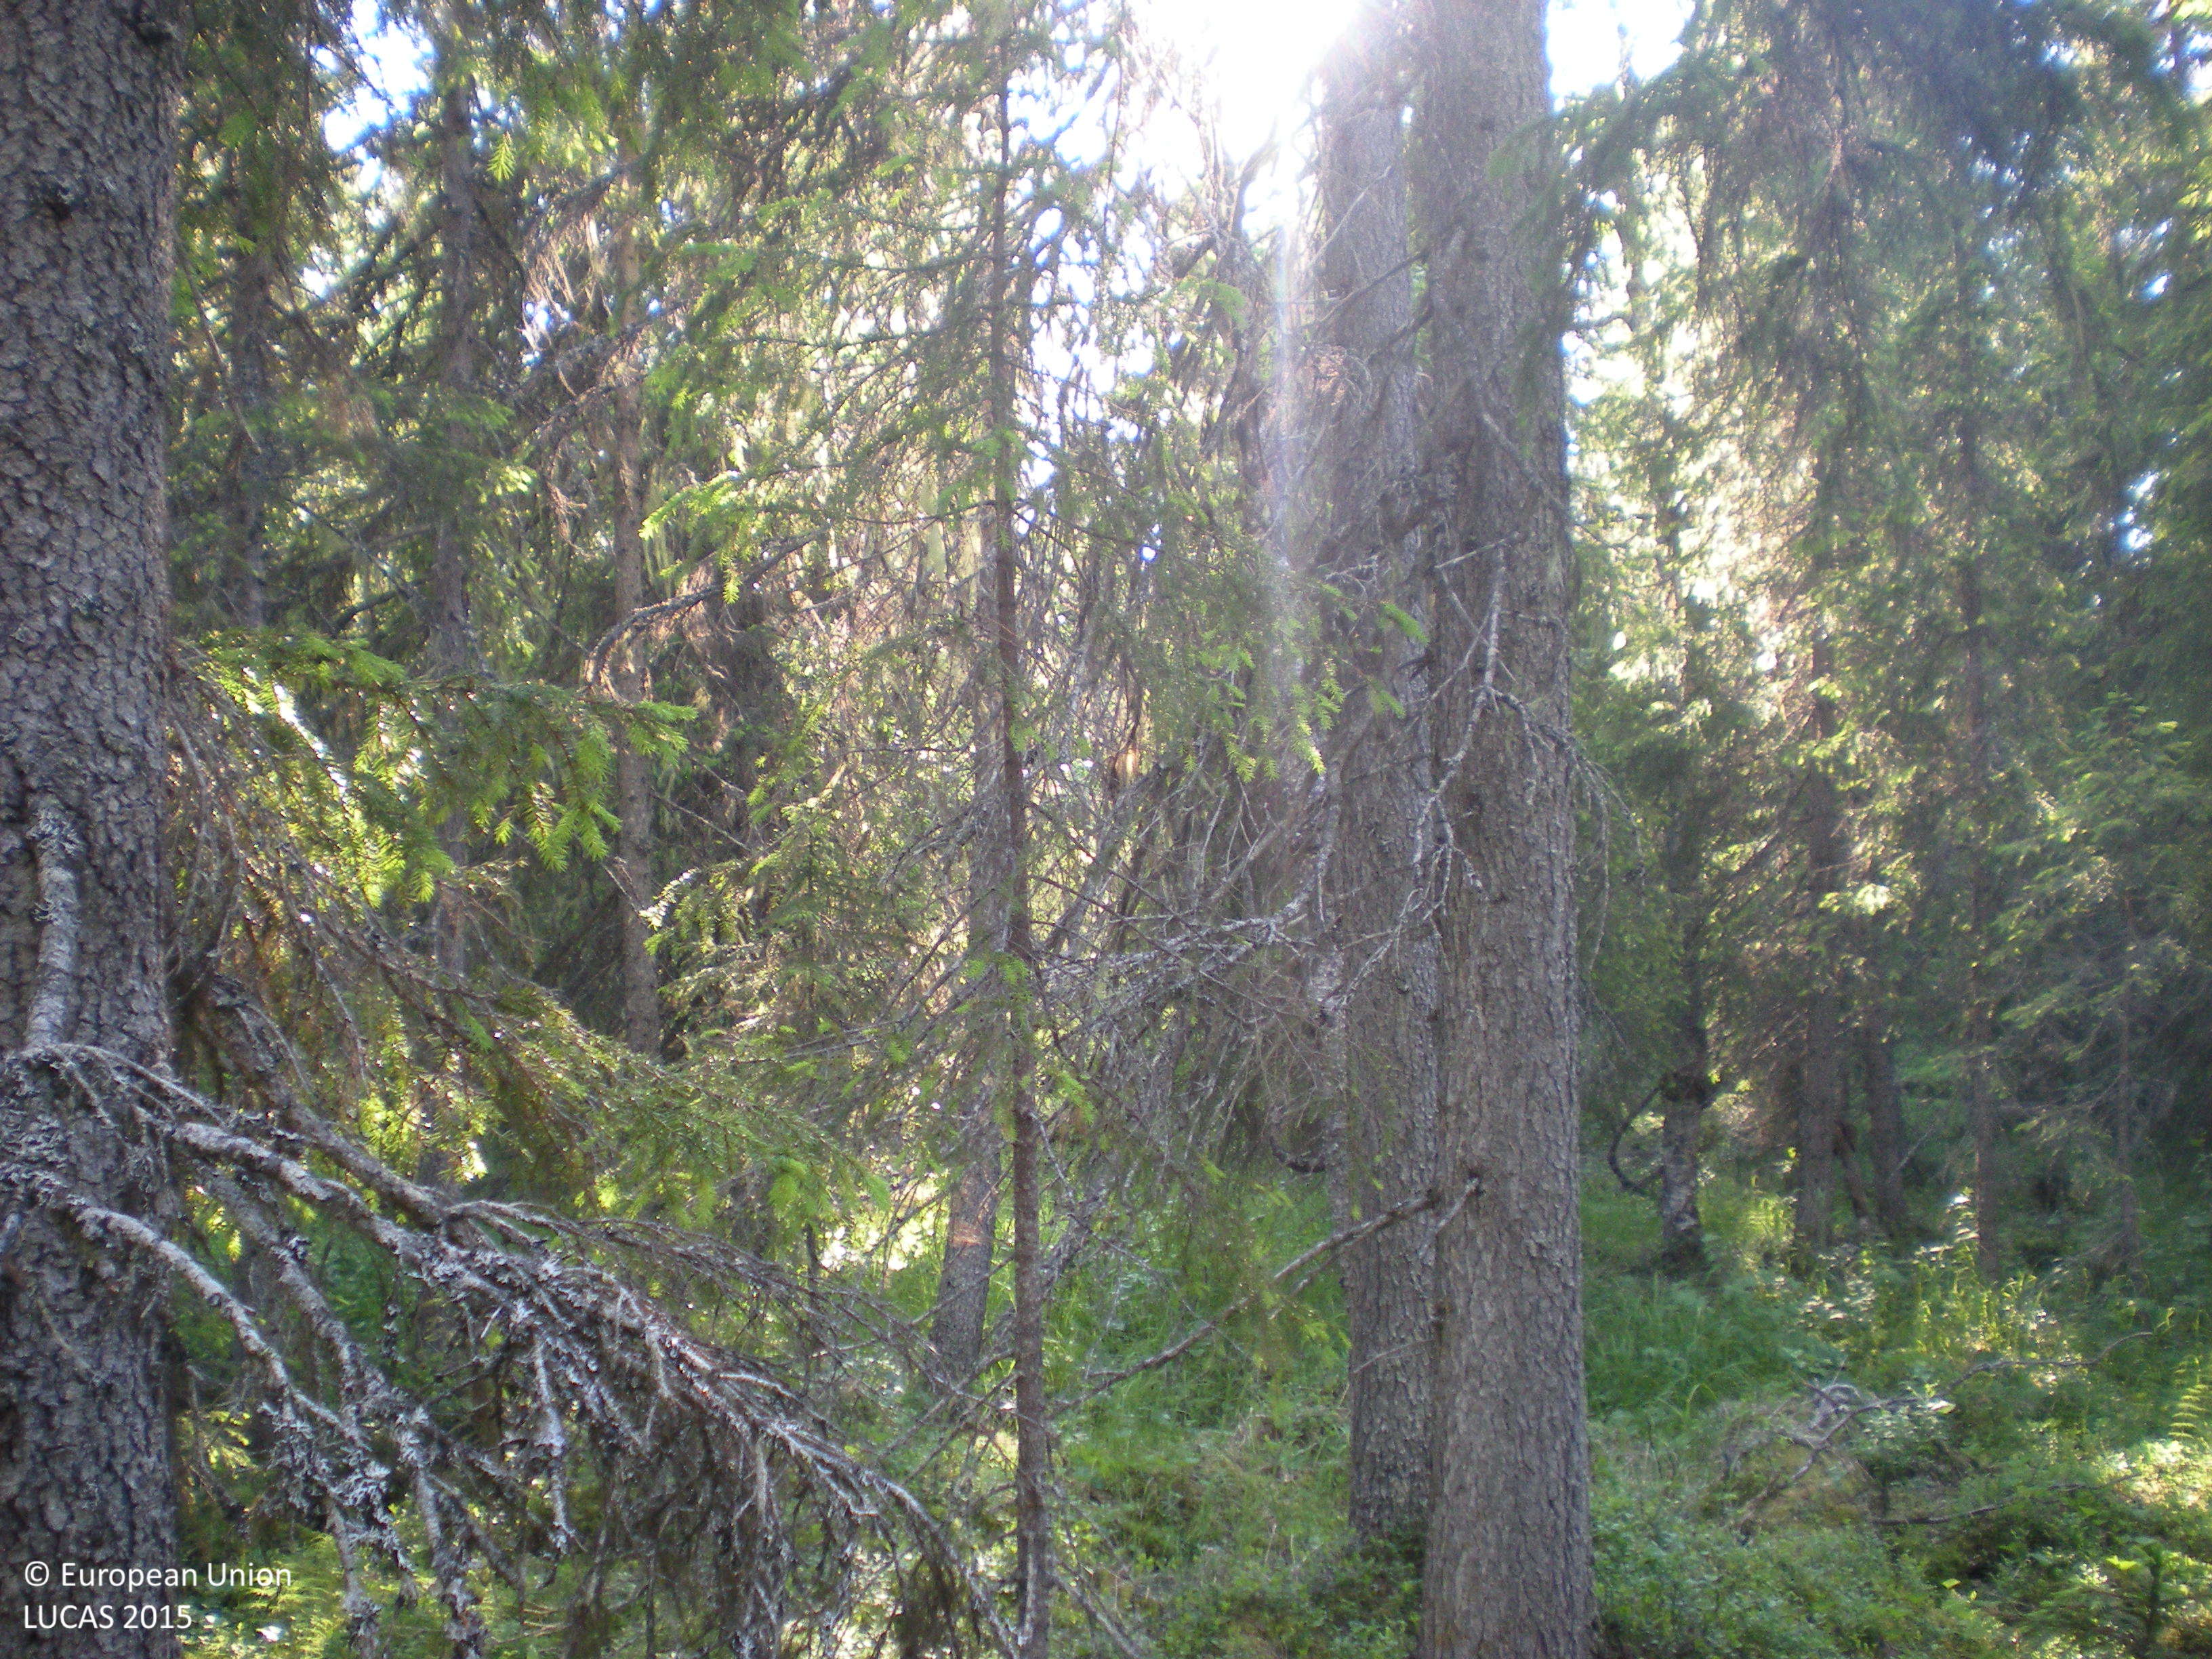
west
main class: Woodland
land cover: Spruce dominated mixed woodland
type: boreal forest
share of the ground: > 75 %
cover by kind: coniferous forest trees 50 %, broadleaved forest trees 25 %, shrubs 20 %, lichens and mosses 5 %
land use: Forestry
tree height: > 5 m
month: July
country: SE
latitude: 65.6061
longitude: 16.9686
